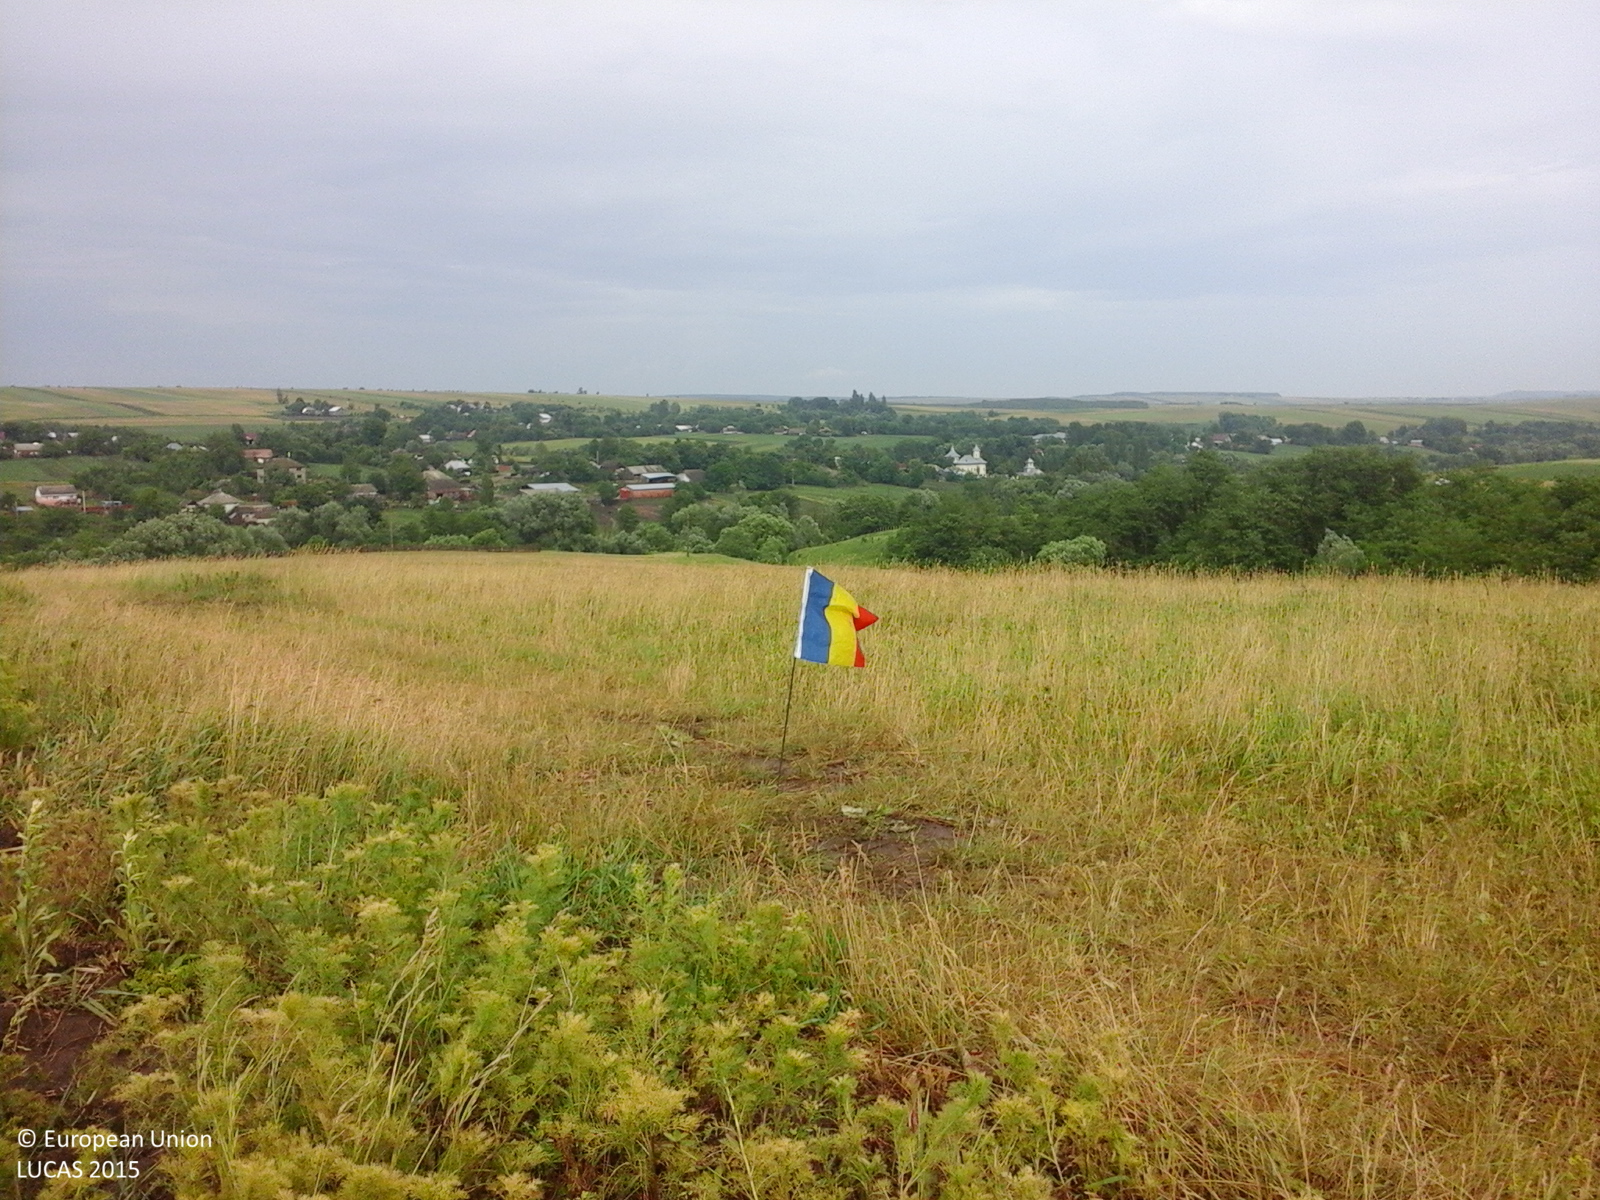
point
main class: Grassland
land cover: Grassland without tree/shrub cover
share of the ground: 25 - 50 %
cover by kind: herbaceous plants 100 %
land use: Agriculture (excluding fallow land and kitchen gardens)
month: June
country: RO
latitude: 47.3852
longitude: 26.4188
